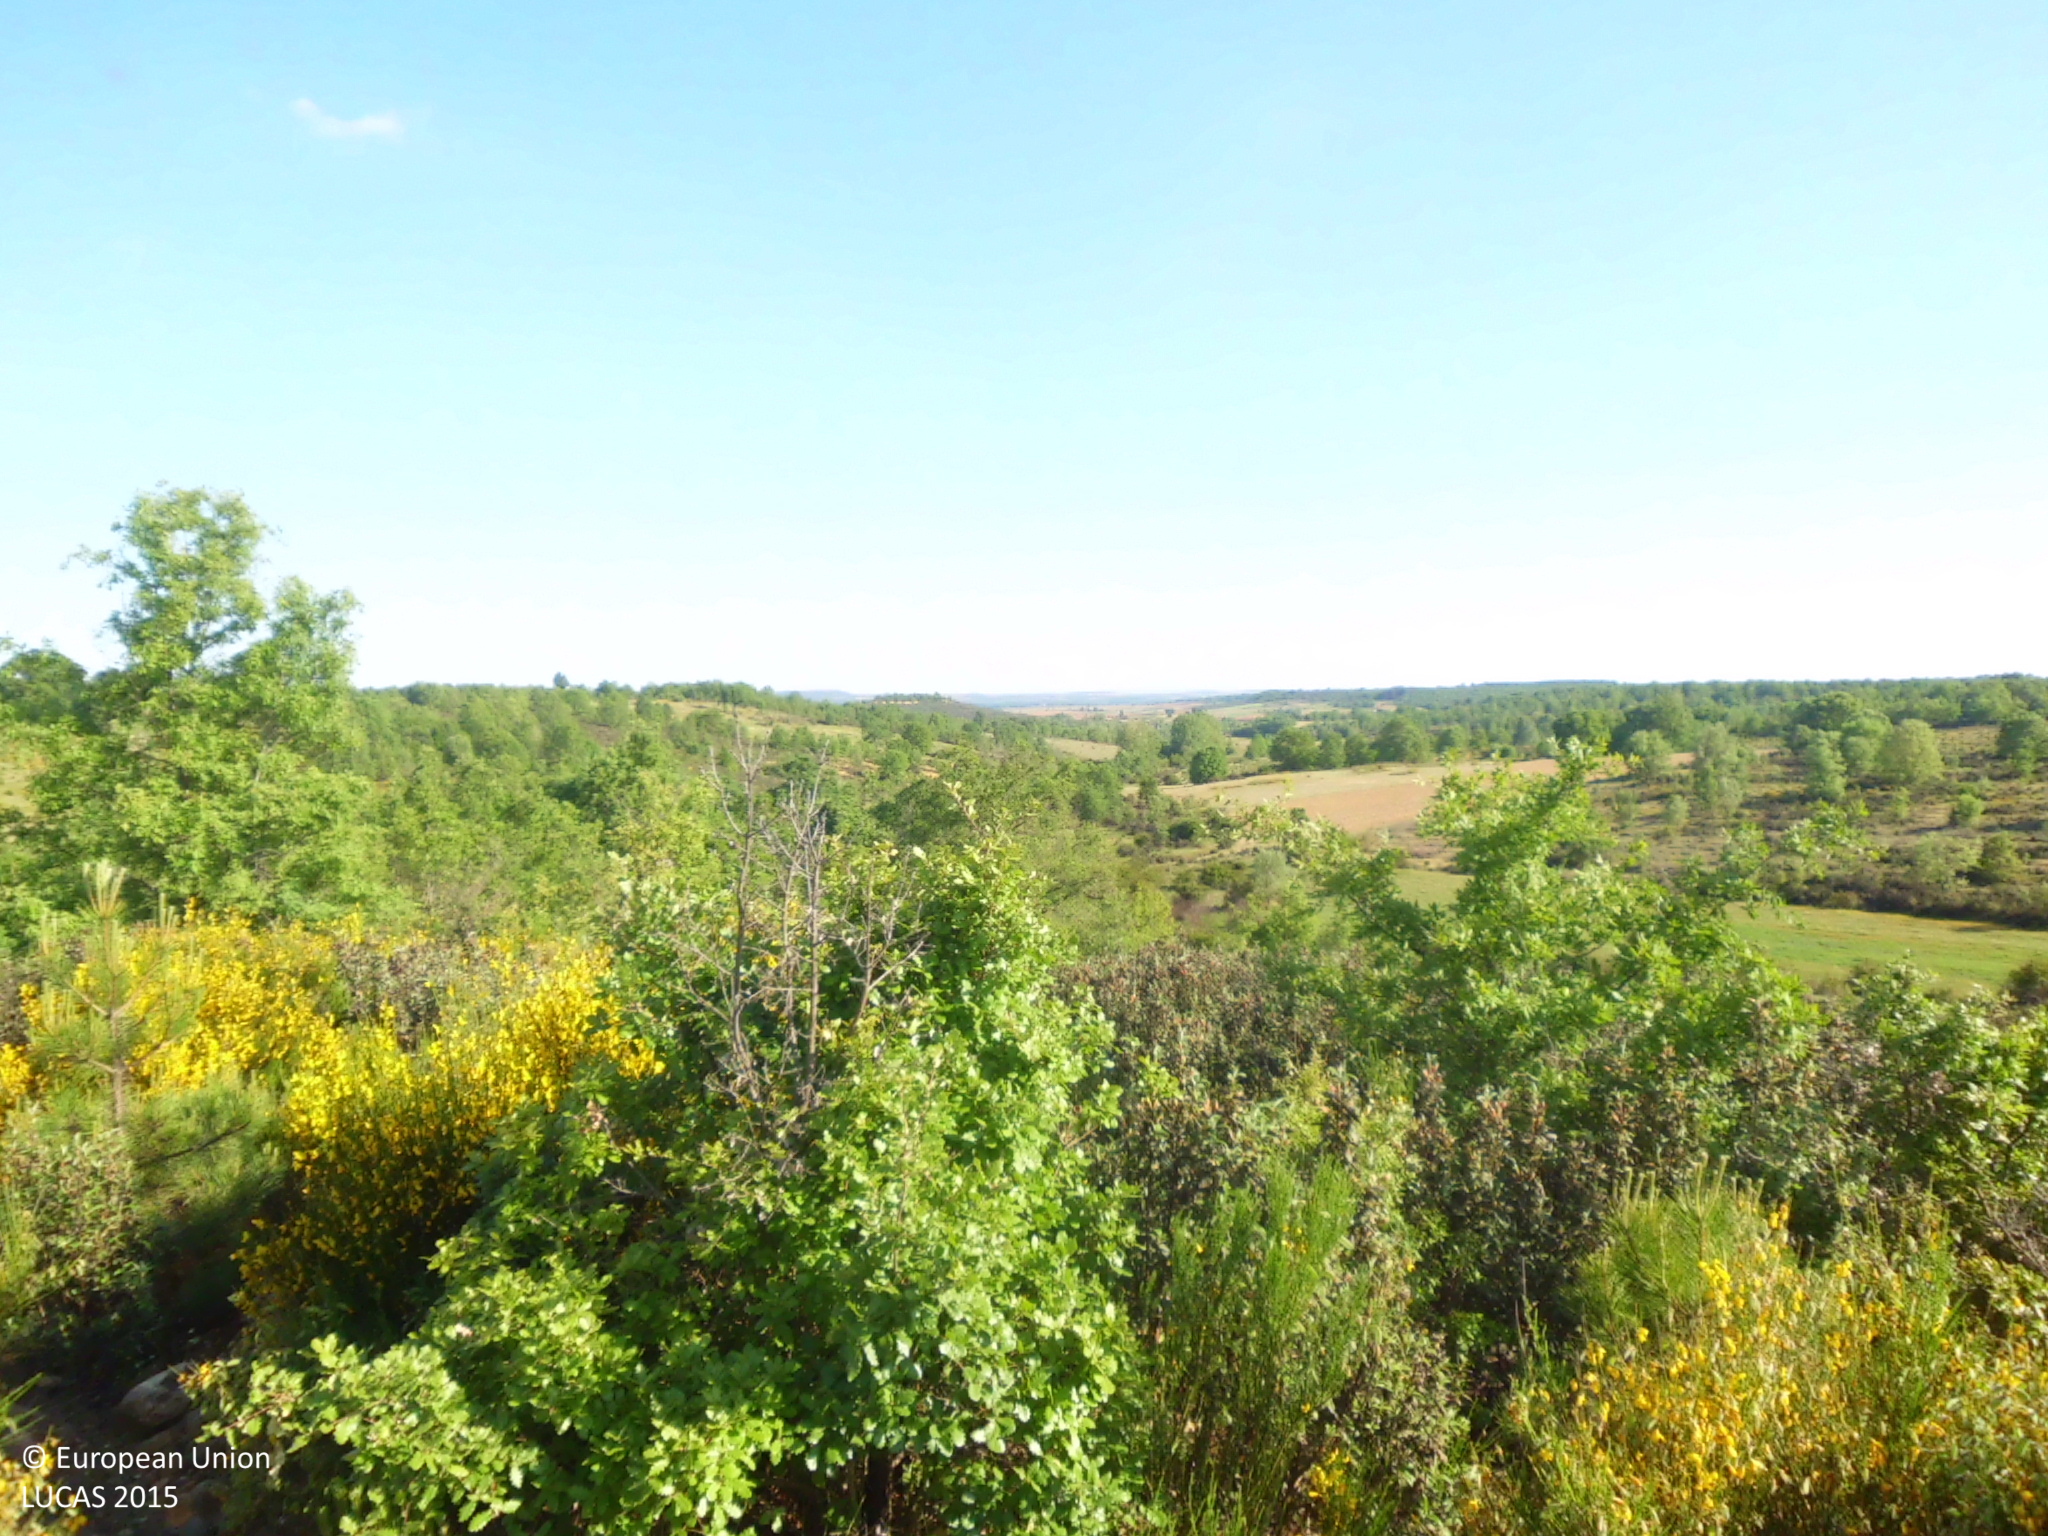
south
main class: Shrubland
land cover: Shrubland with sparse tree cover
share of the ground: 50 - 75 %
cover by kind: shrubs 55 %, herbaceous plants 20 %, unconsolidated bare surface 20 %, coniferous forest trees 5 %
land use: Forestry
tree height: < 5 m
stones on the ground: > 50 %
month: May
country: ES
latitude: 42.6740
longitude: -5.4337
